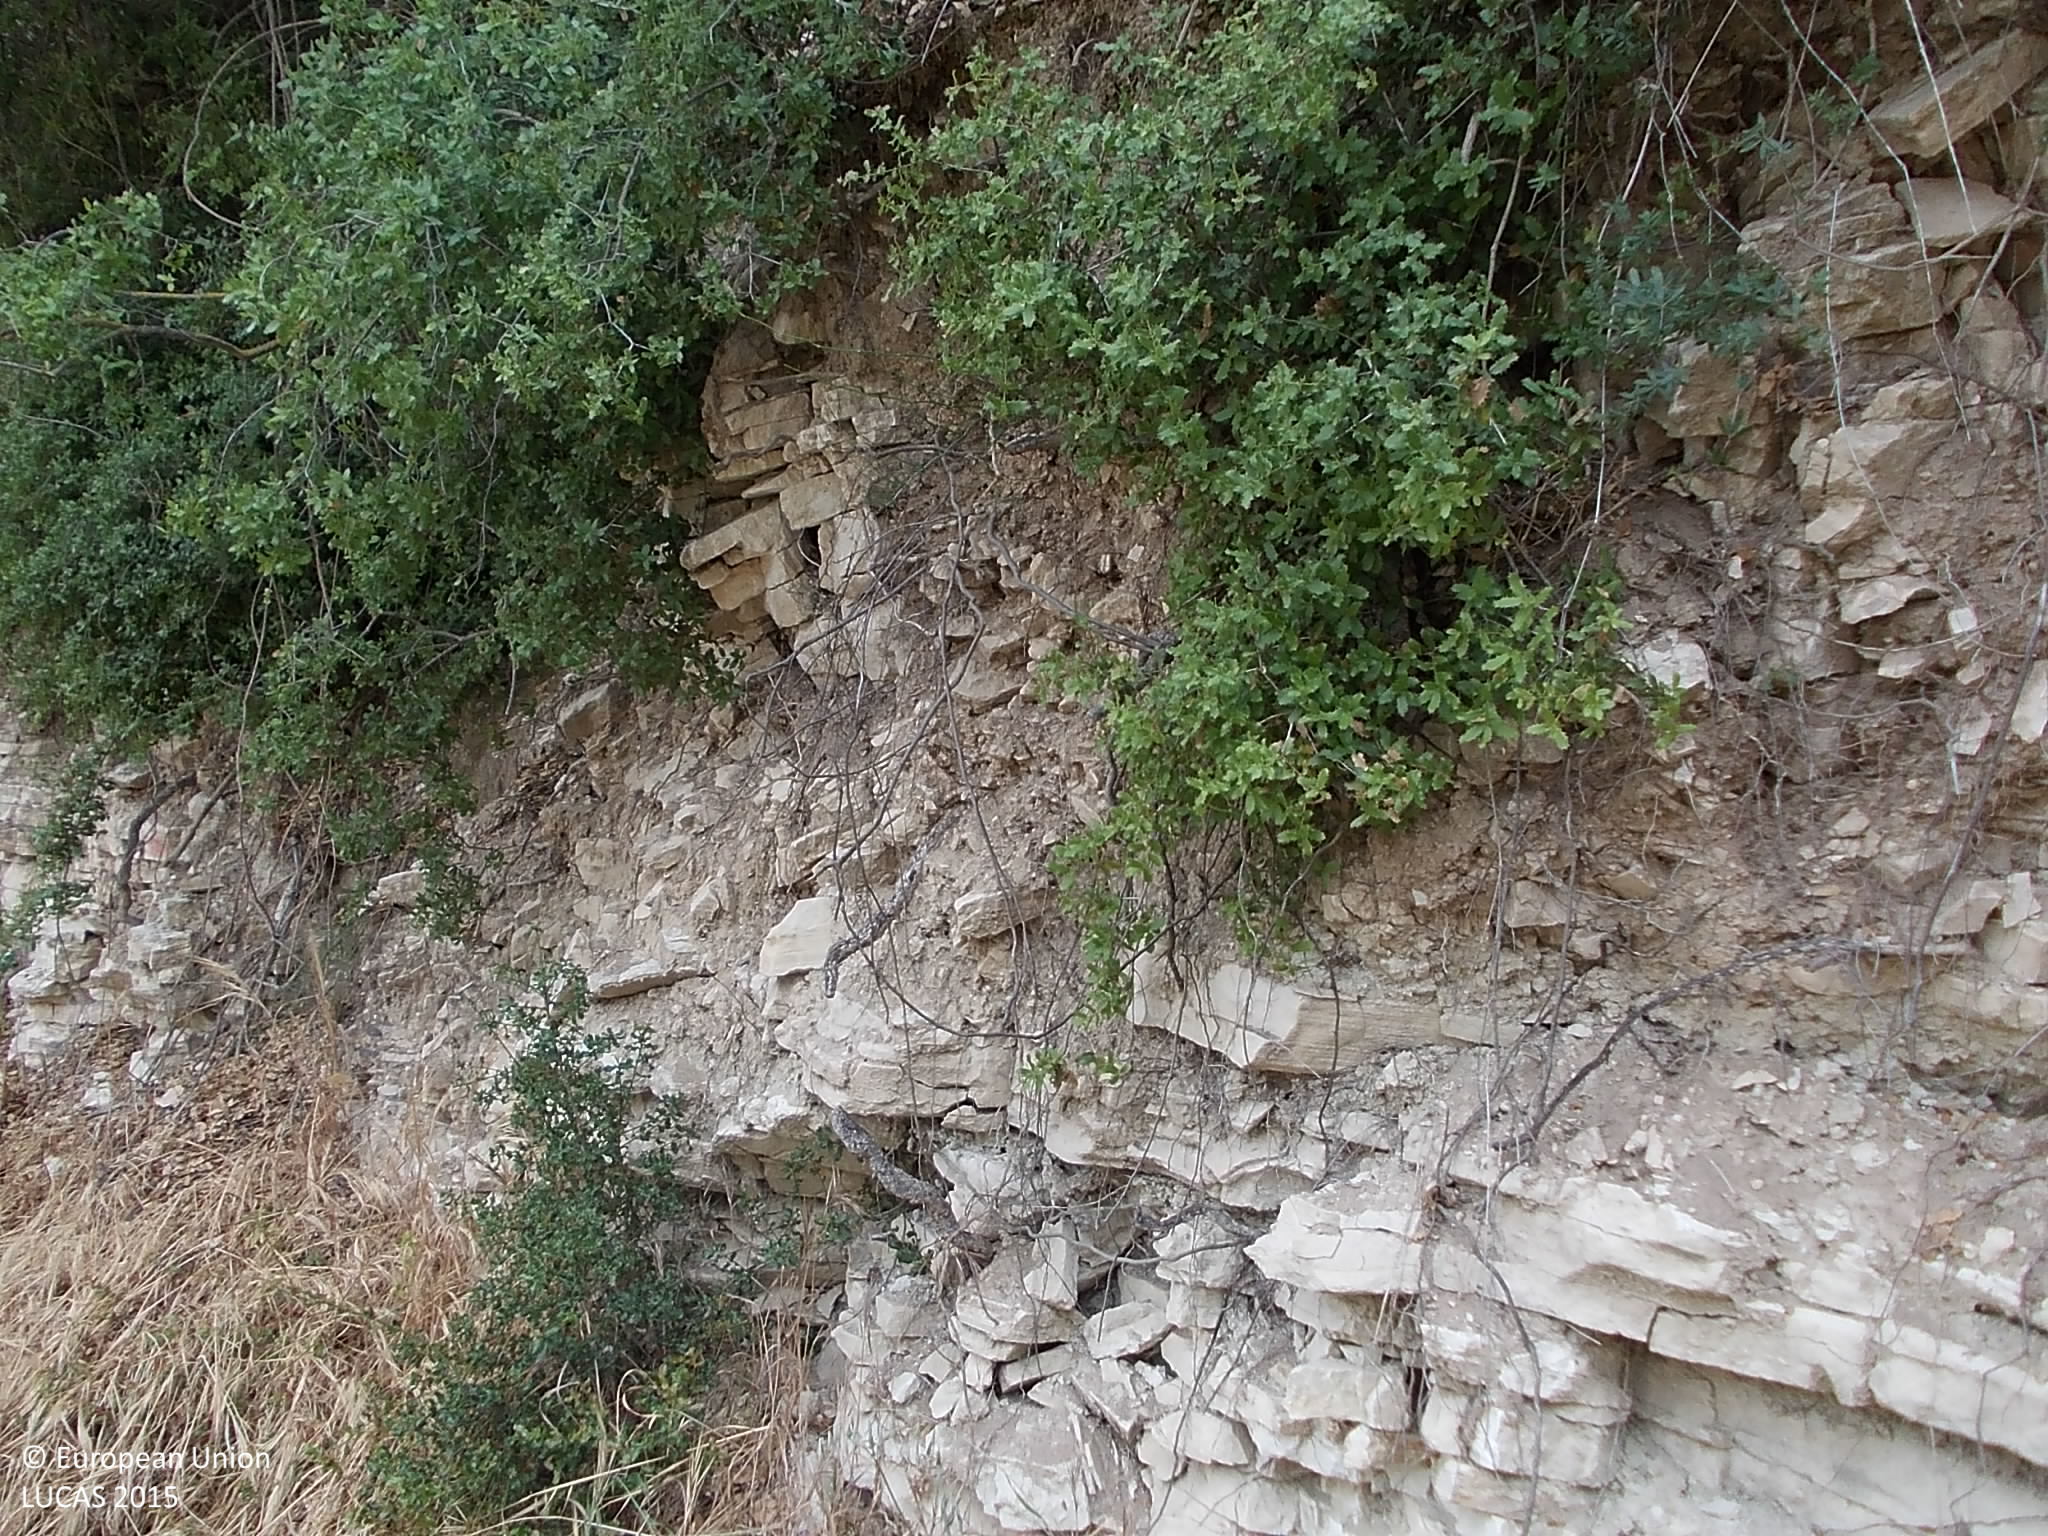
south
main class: Woodland
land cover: Broadleaved woodland
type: broadleaved evergreen forest
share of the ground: 10 - 25 %
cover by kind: shrubs 65 %, broadleaved forest trees 15 %, herbaceous plants 10 %, unconsolidated bare surface 10 %
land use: Semi-natural and natural areas not in use
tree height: > 5 m
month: May
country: CY
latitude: 34.8252
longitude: 32.8039
